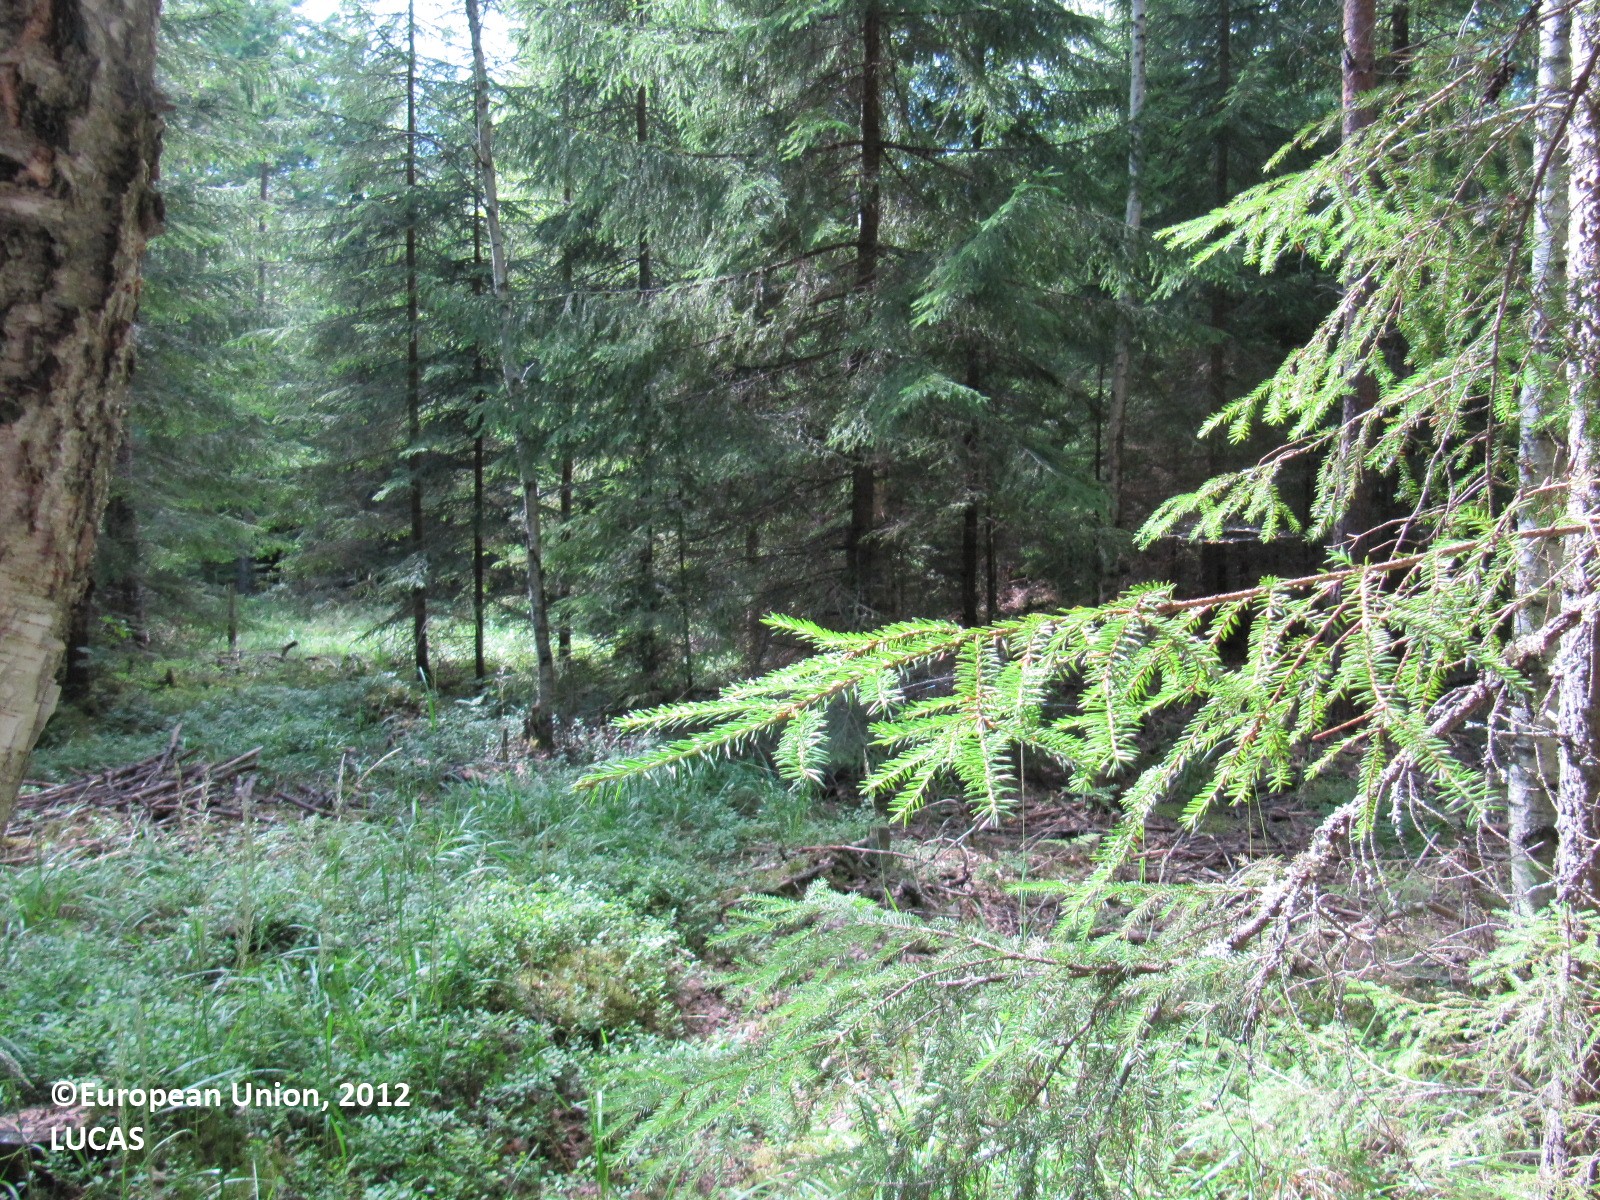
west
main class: Woodland
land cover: Spruce dominated mixed woodland
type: boreal forest
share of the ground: > 75 %
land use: Forestry
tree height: > 5 m
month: July
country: FI
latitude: 61.0152
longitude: 24.2117
